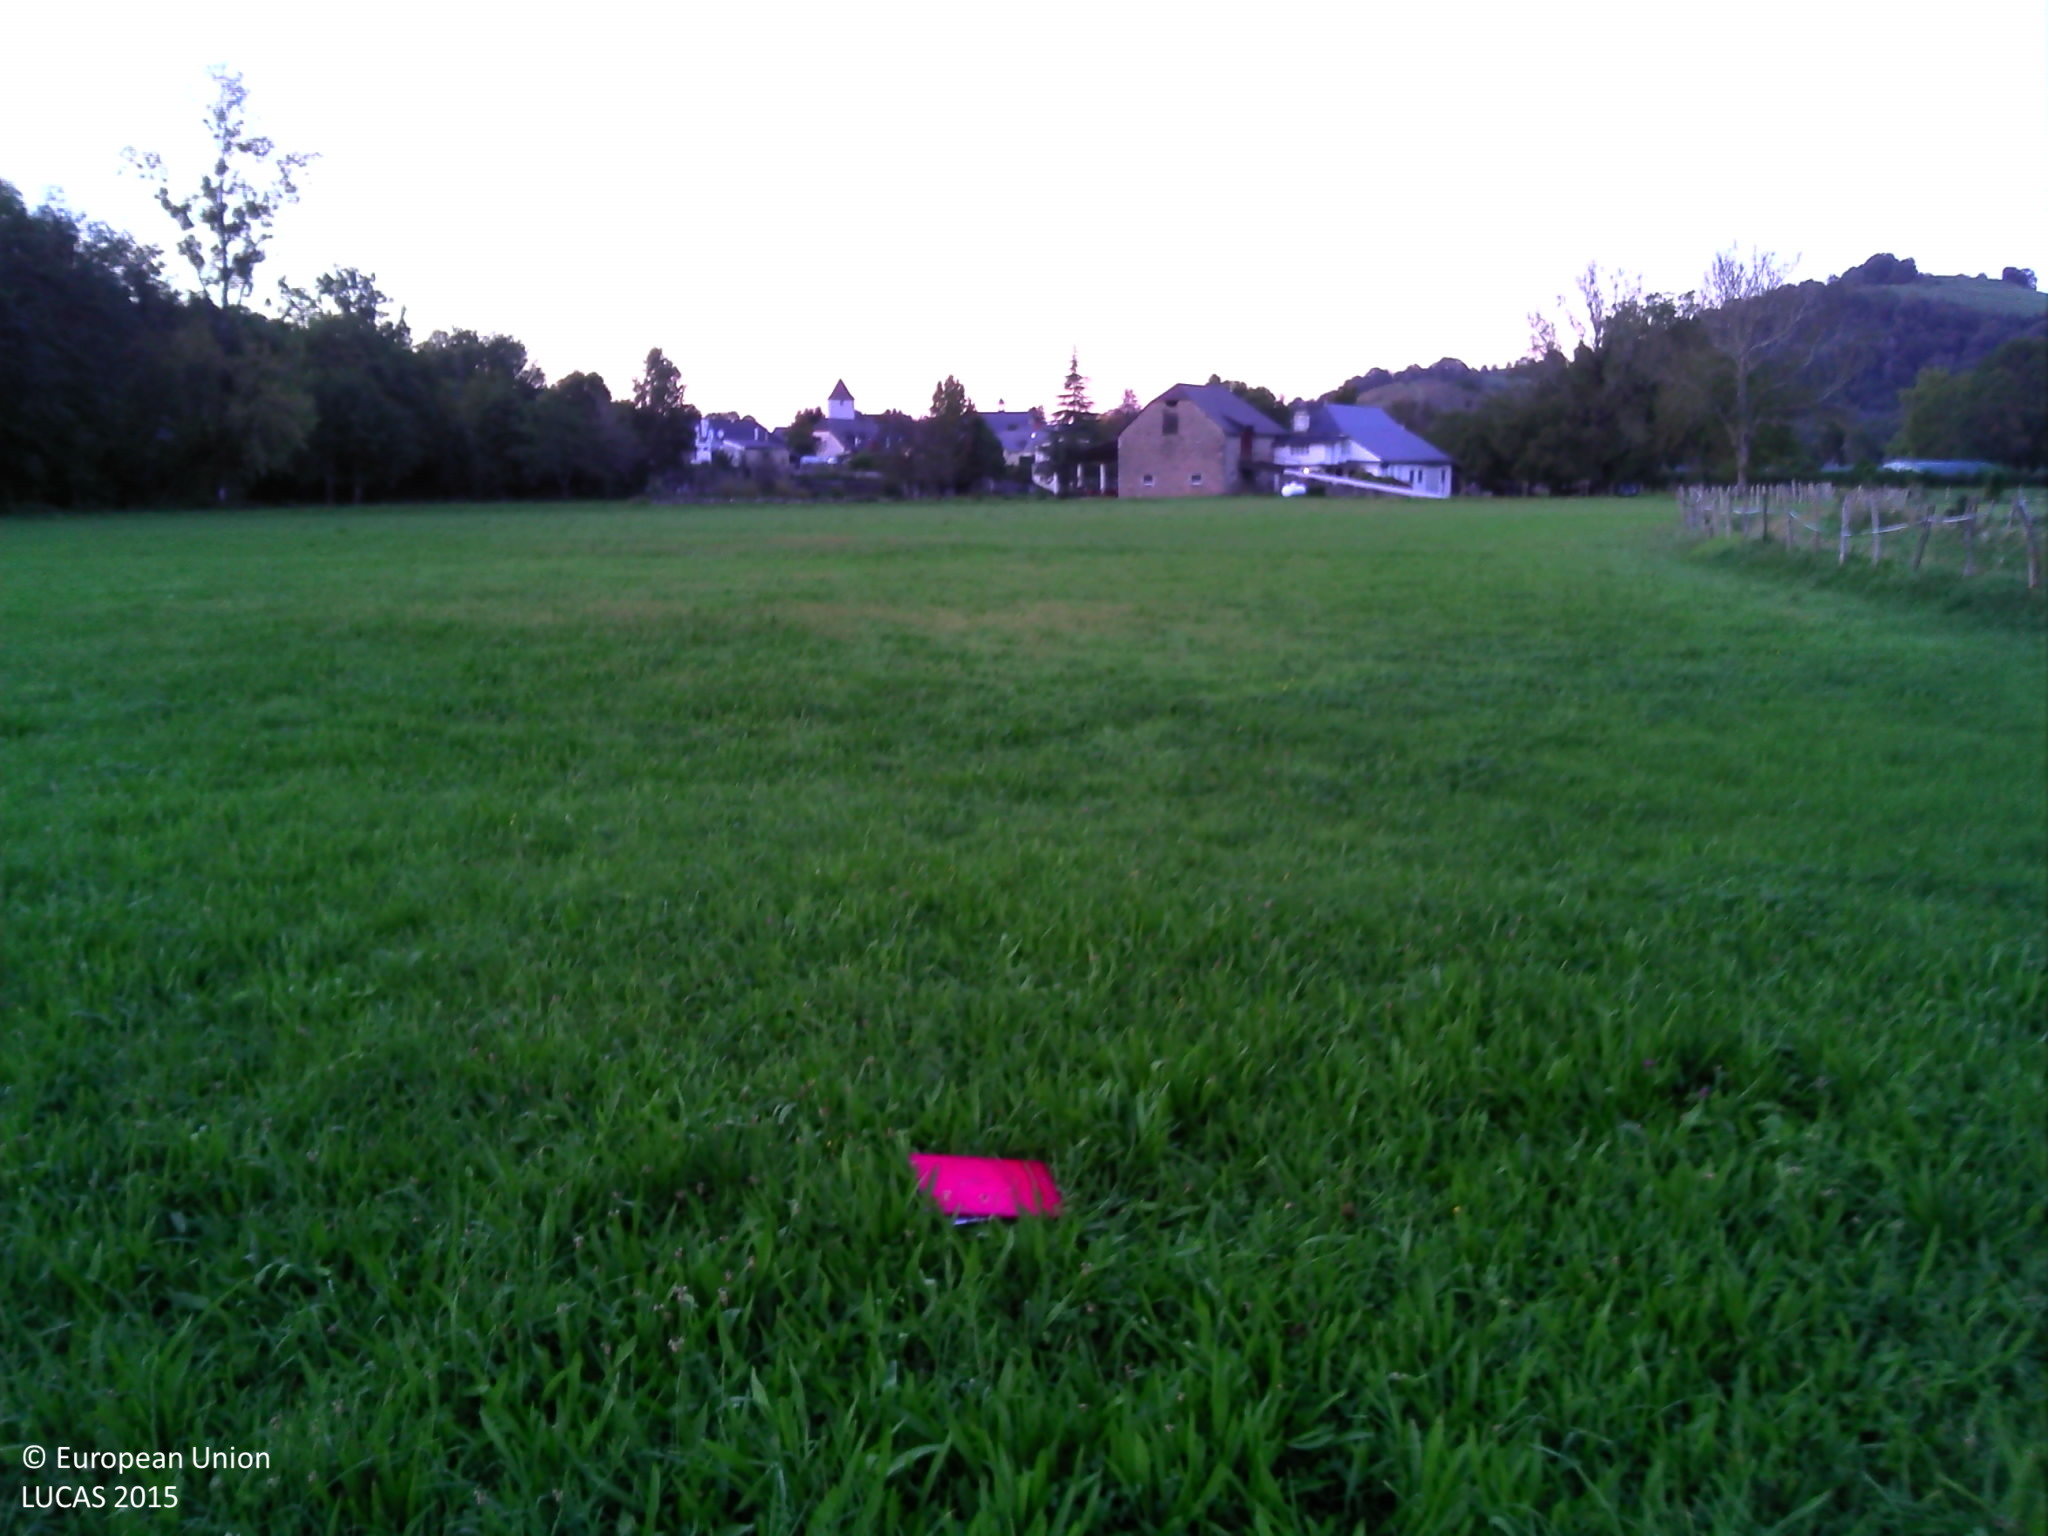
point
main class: Grassland
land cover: Grassland without tree/shrub cover
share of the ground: > 75 %
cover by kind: herbaceous plants 100 %
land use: Agriculture (excluding fallow land and kitchen gardens)
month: September
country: FR
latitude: 43.1418
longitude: -0.6927
